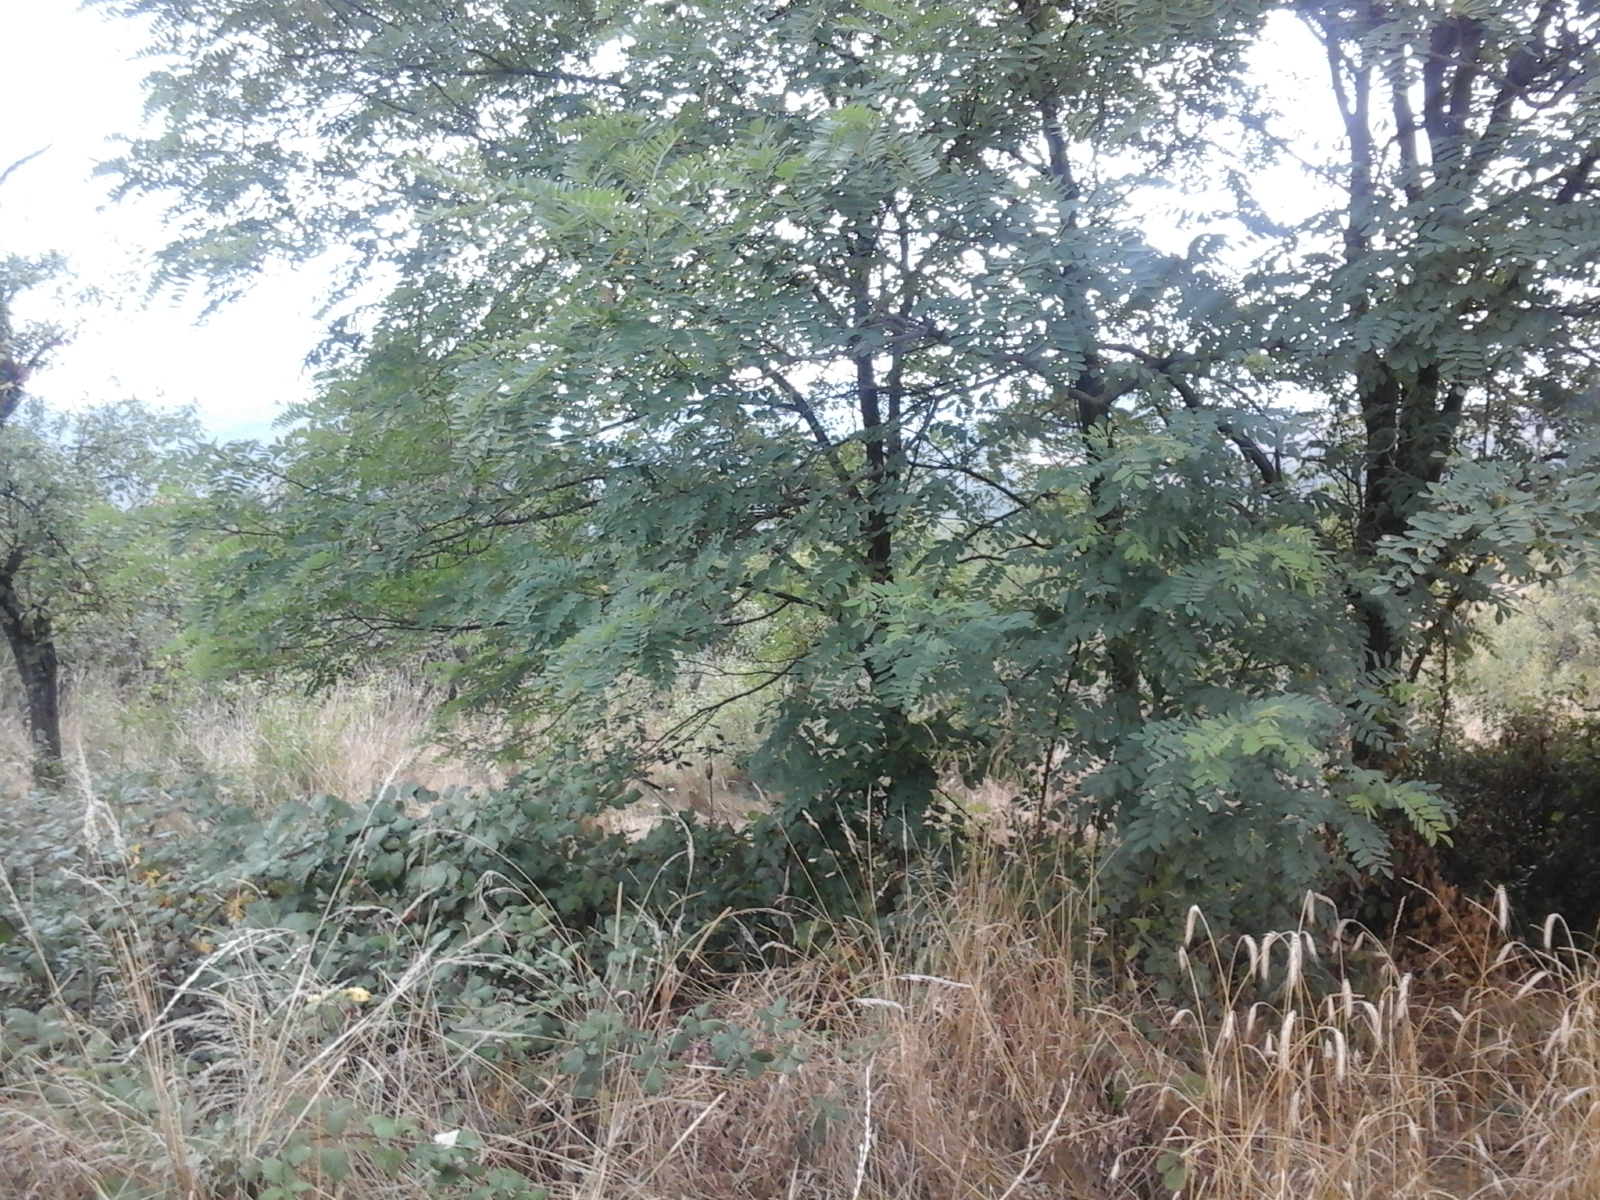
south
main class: Cropland
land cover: Common wheat
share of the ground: > 75 %
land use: Agriculture (excluding fallow land and kitchen gardens)
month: August
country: RO
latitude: 45.2151
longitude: 21.8645
